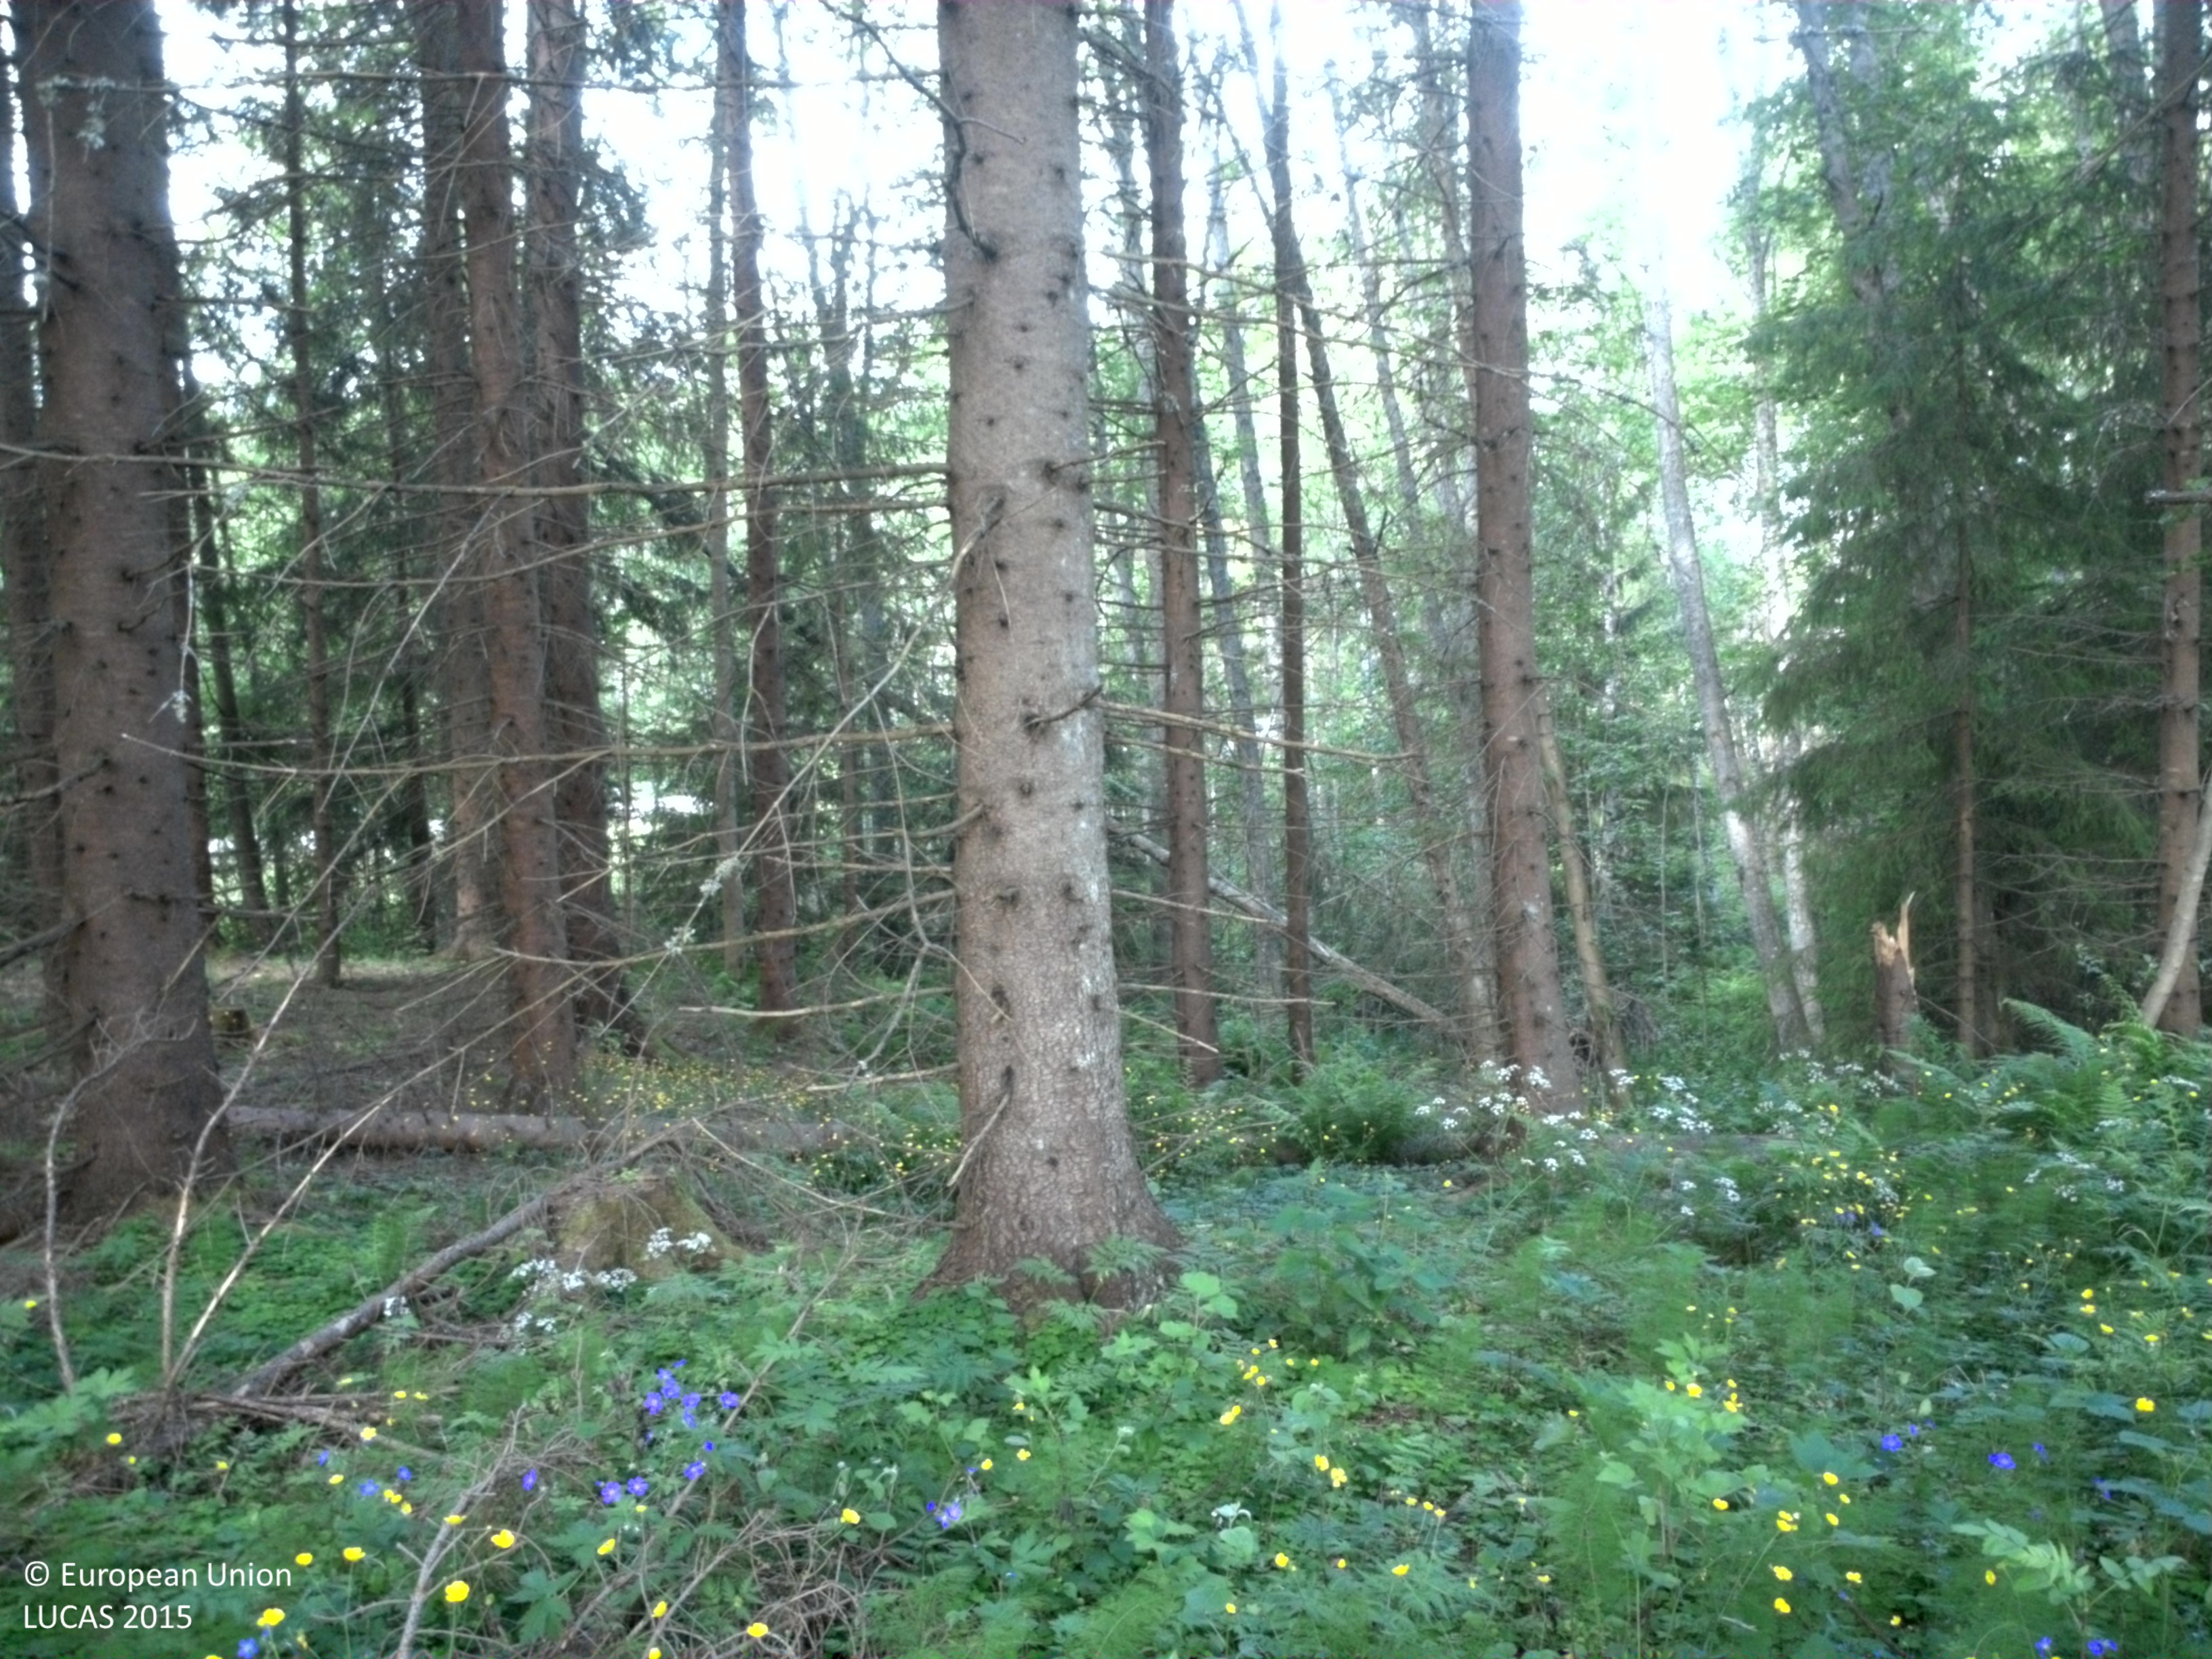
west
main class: Woodland
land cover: Spruce dominated coniferous woodland
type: boreal forest
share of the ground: > 75 %
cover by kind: coniferous forest trees 75 %, herbaceous plants 15 %, broadleaved forest trees 5 %, lichens and mosses 5 %
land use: Forestry
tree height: > 5 m
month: June
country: SE
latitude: 59.8013
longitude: 12.3284
